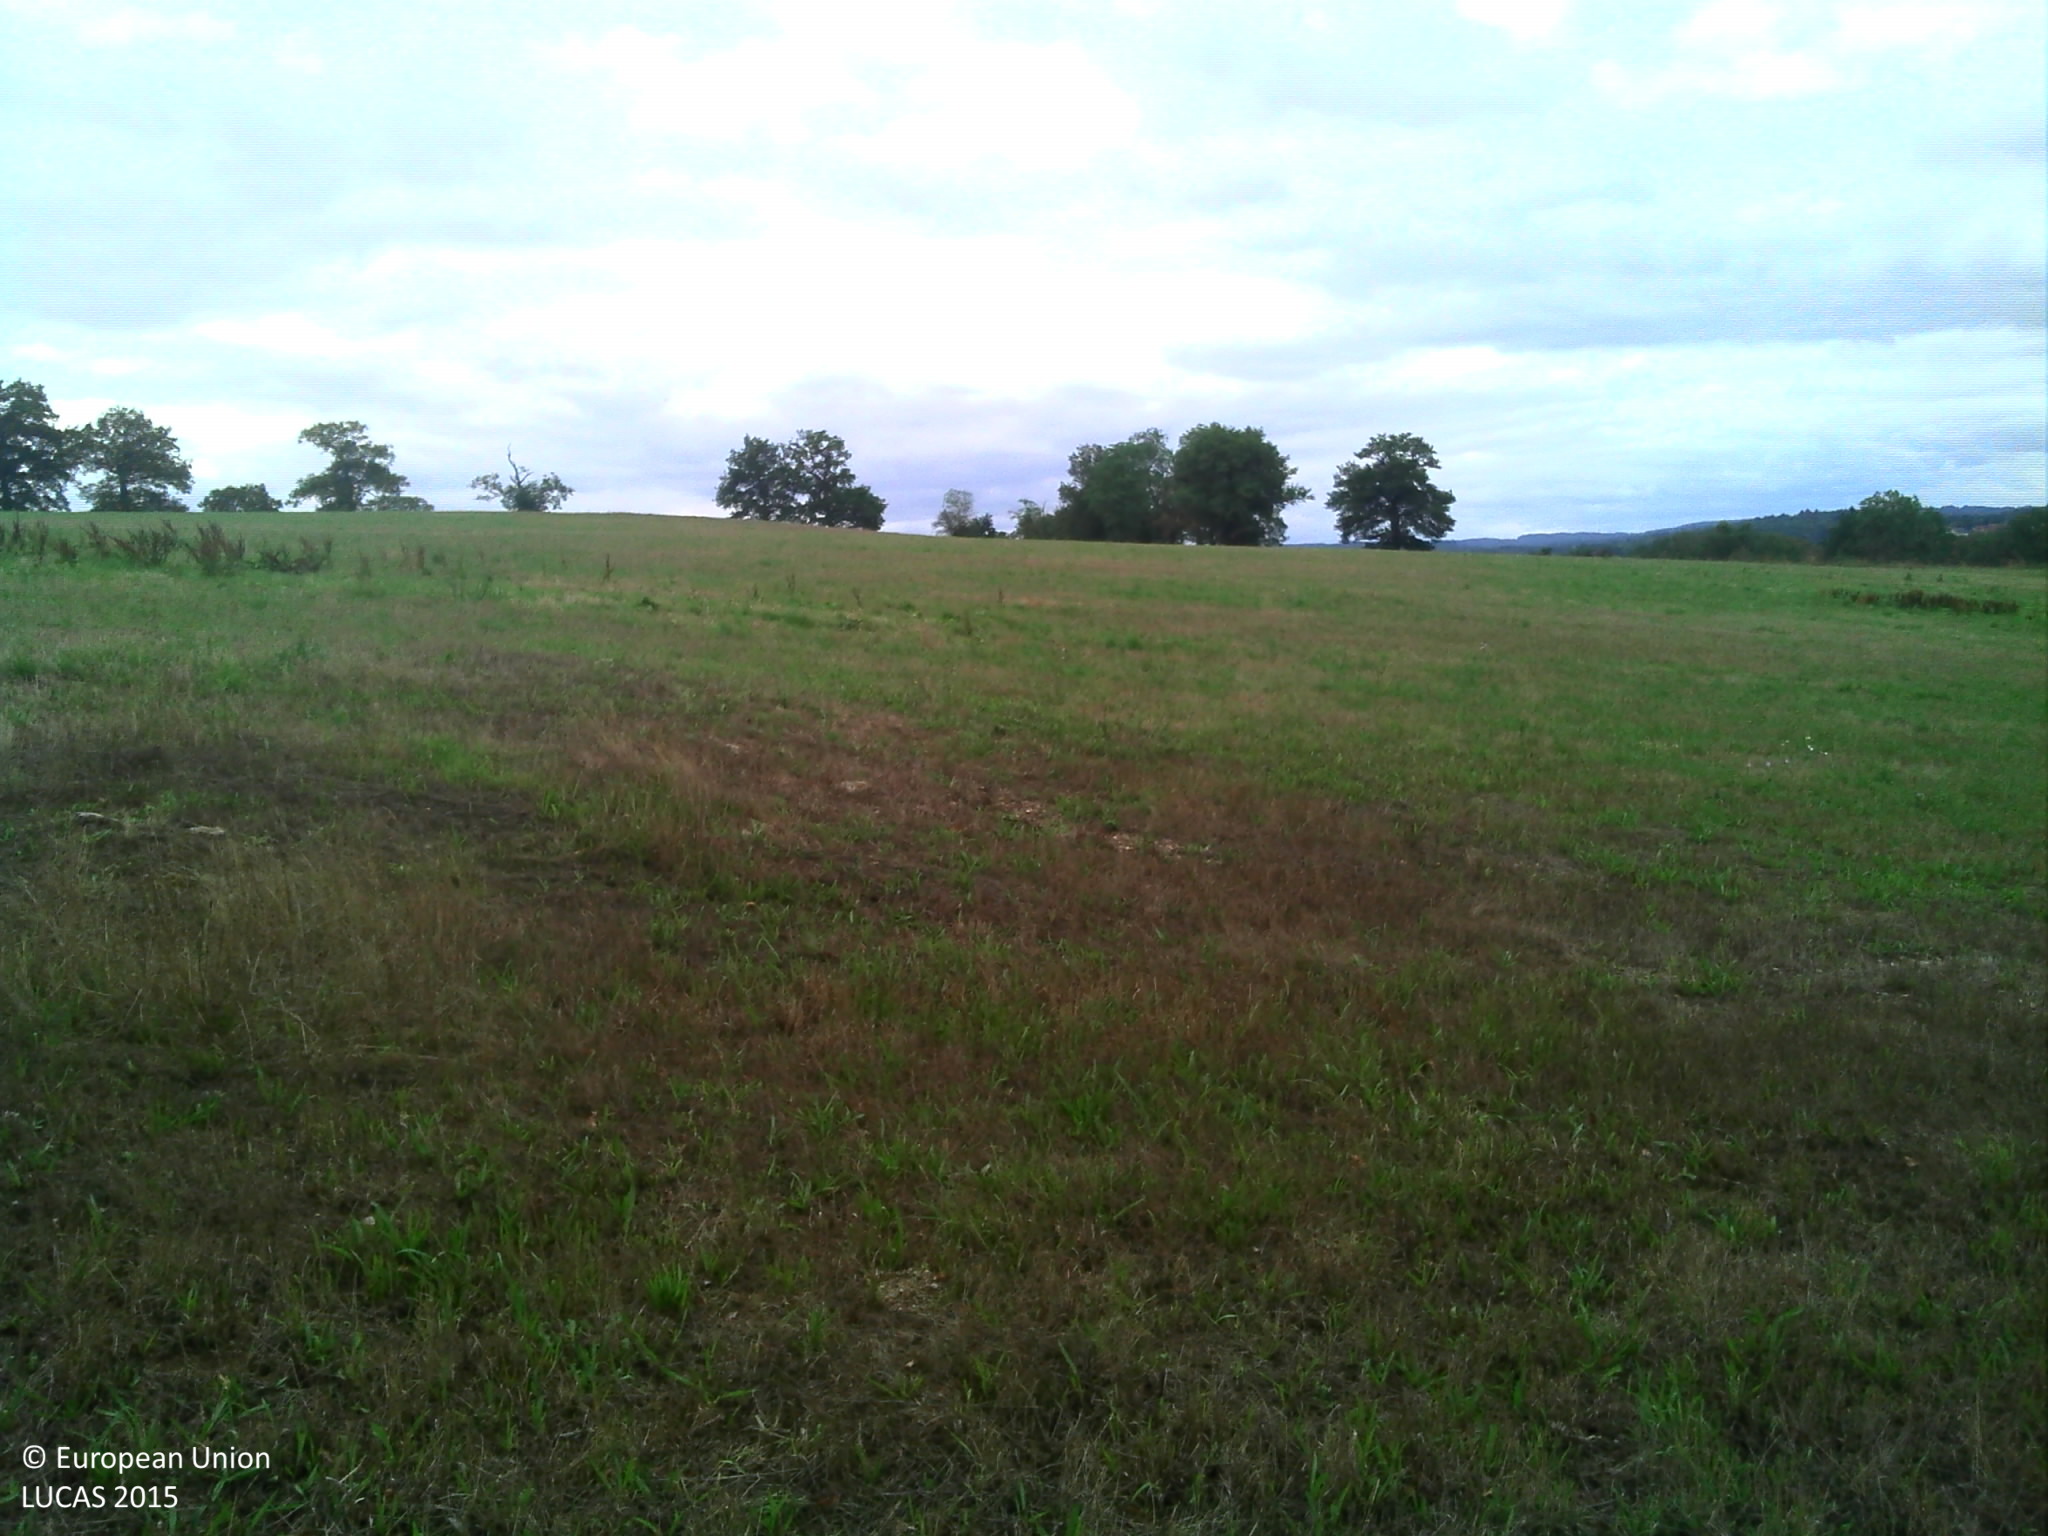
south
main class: Grassland
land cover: Grassland without tree/shrub cover
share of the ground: > 75 %
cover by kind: herbaceous plants 100 %
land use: Agriculture (excluding fallow land and kitchen gardens)
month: August
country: FR
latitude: 46.1075
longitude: 2.2716
